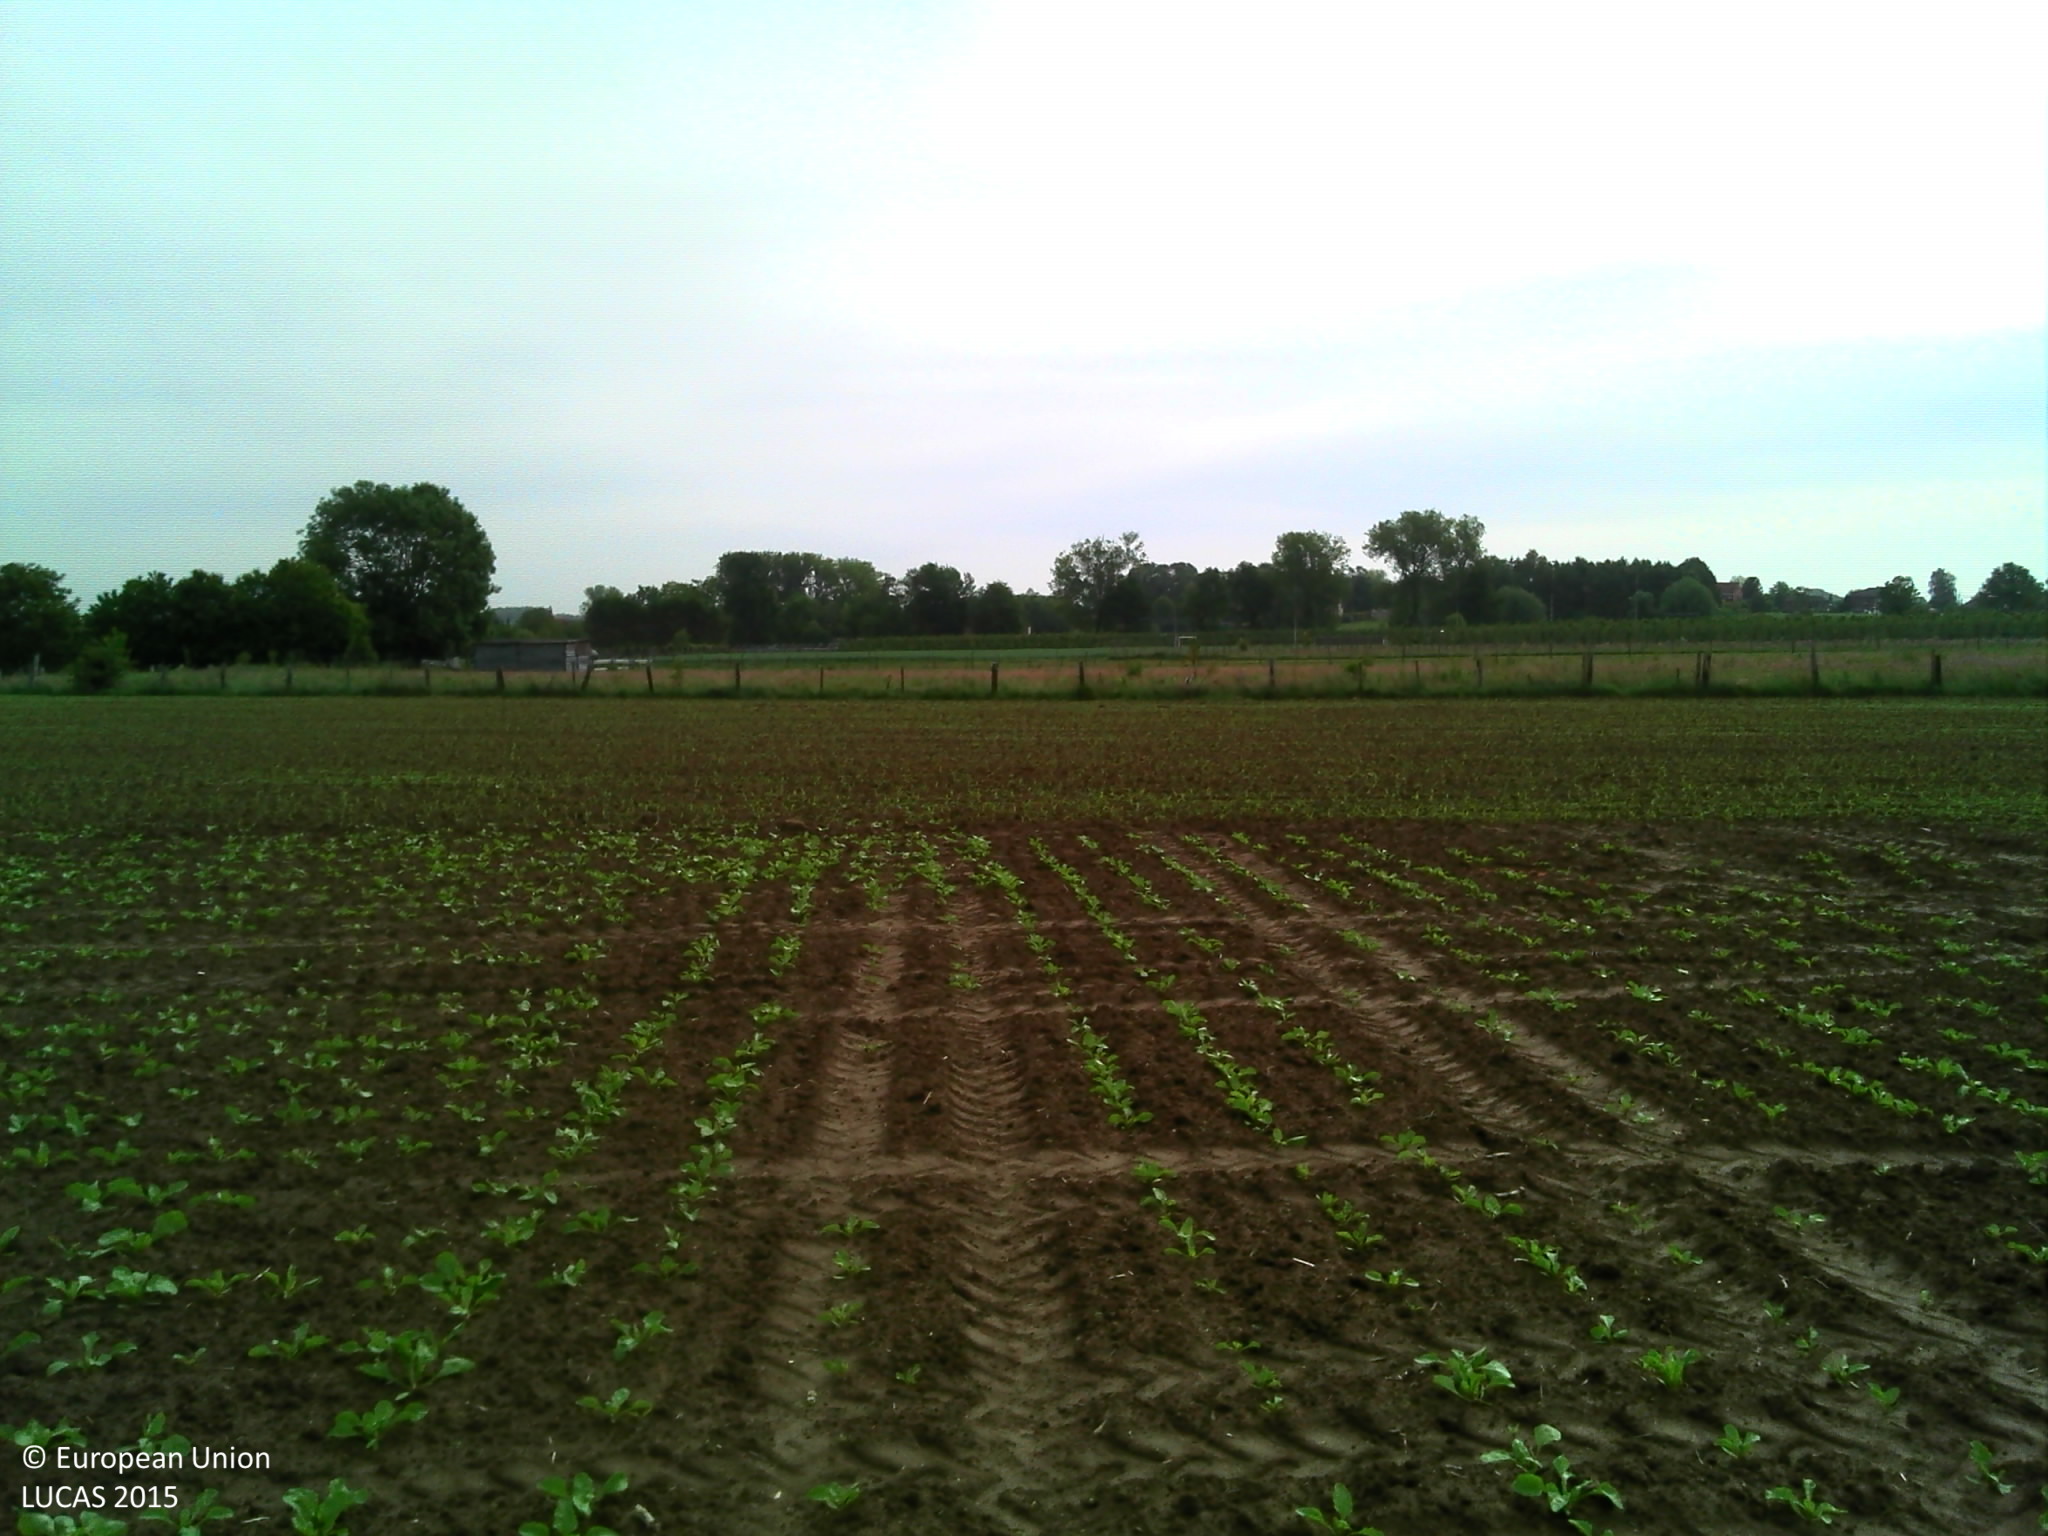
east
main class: Cropland
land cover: Sugar beet
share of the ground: 10 - 25 %
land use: Agriculture (excluding fallow land and kitchen gardens)
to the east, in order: Sugar beet; Fences; Grassland without tree/shrub cover; Fences; Grassland without tree/shrub cover; Fences; Maize; Fences; Apple fruit; Pear fruit
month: June
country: BE
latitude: 50.8264
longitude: 4.1314
